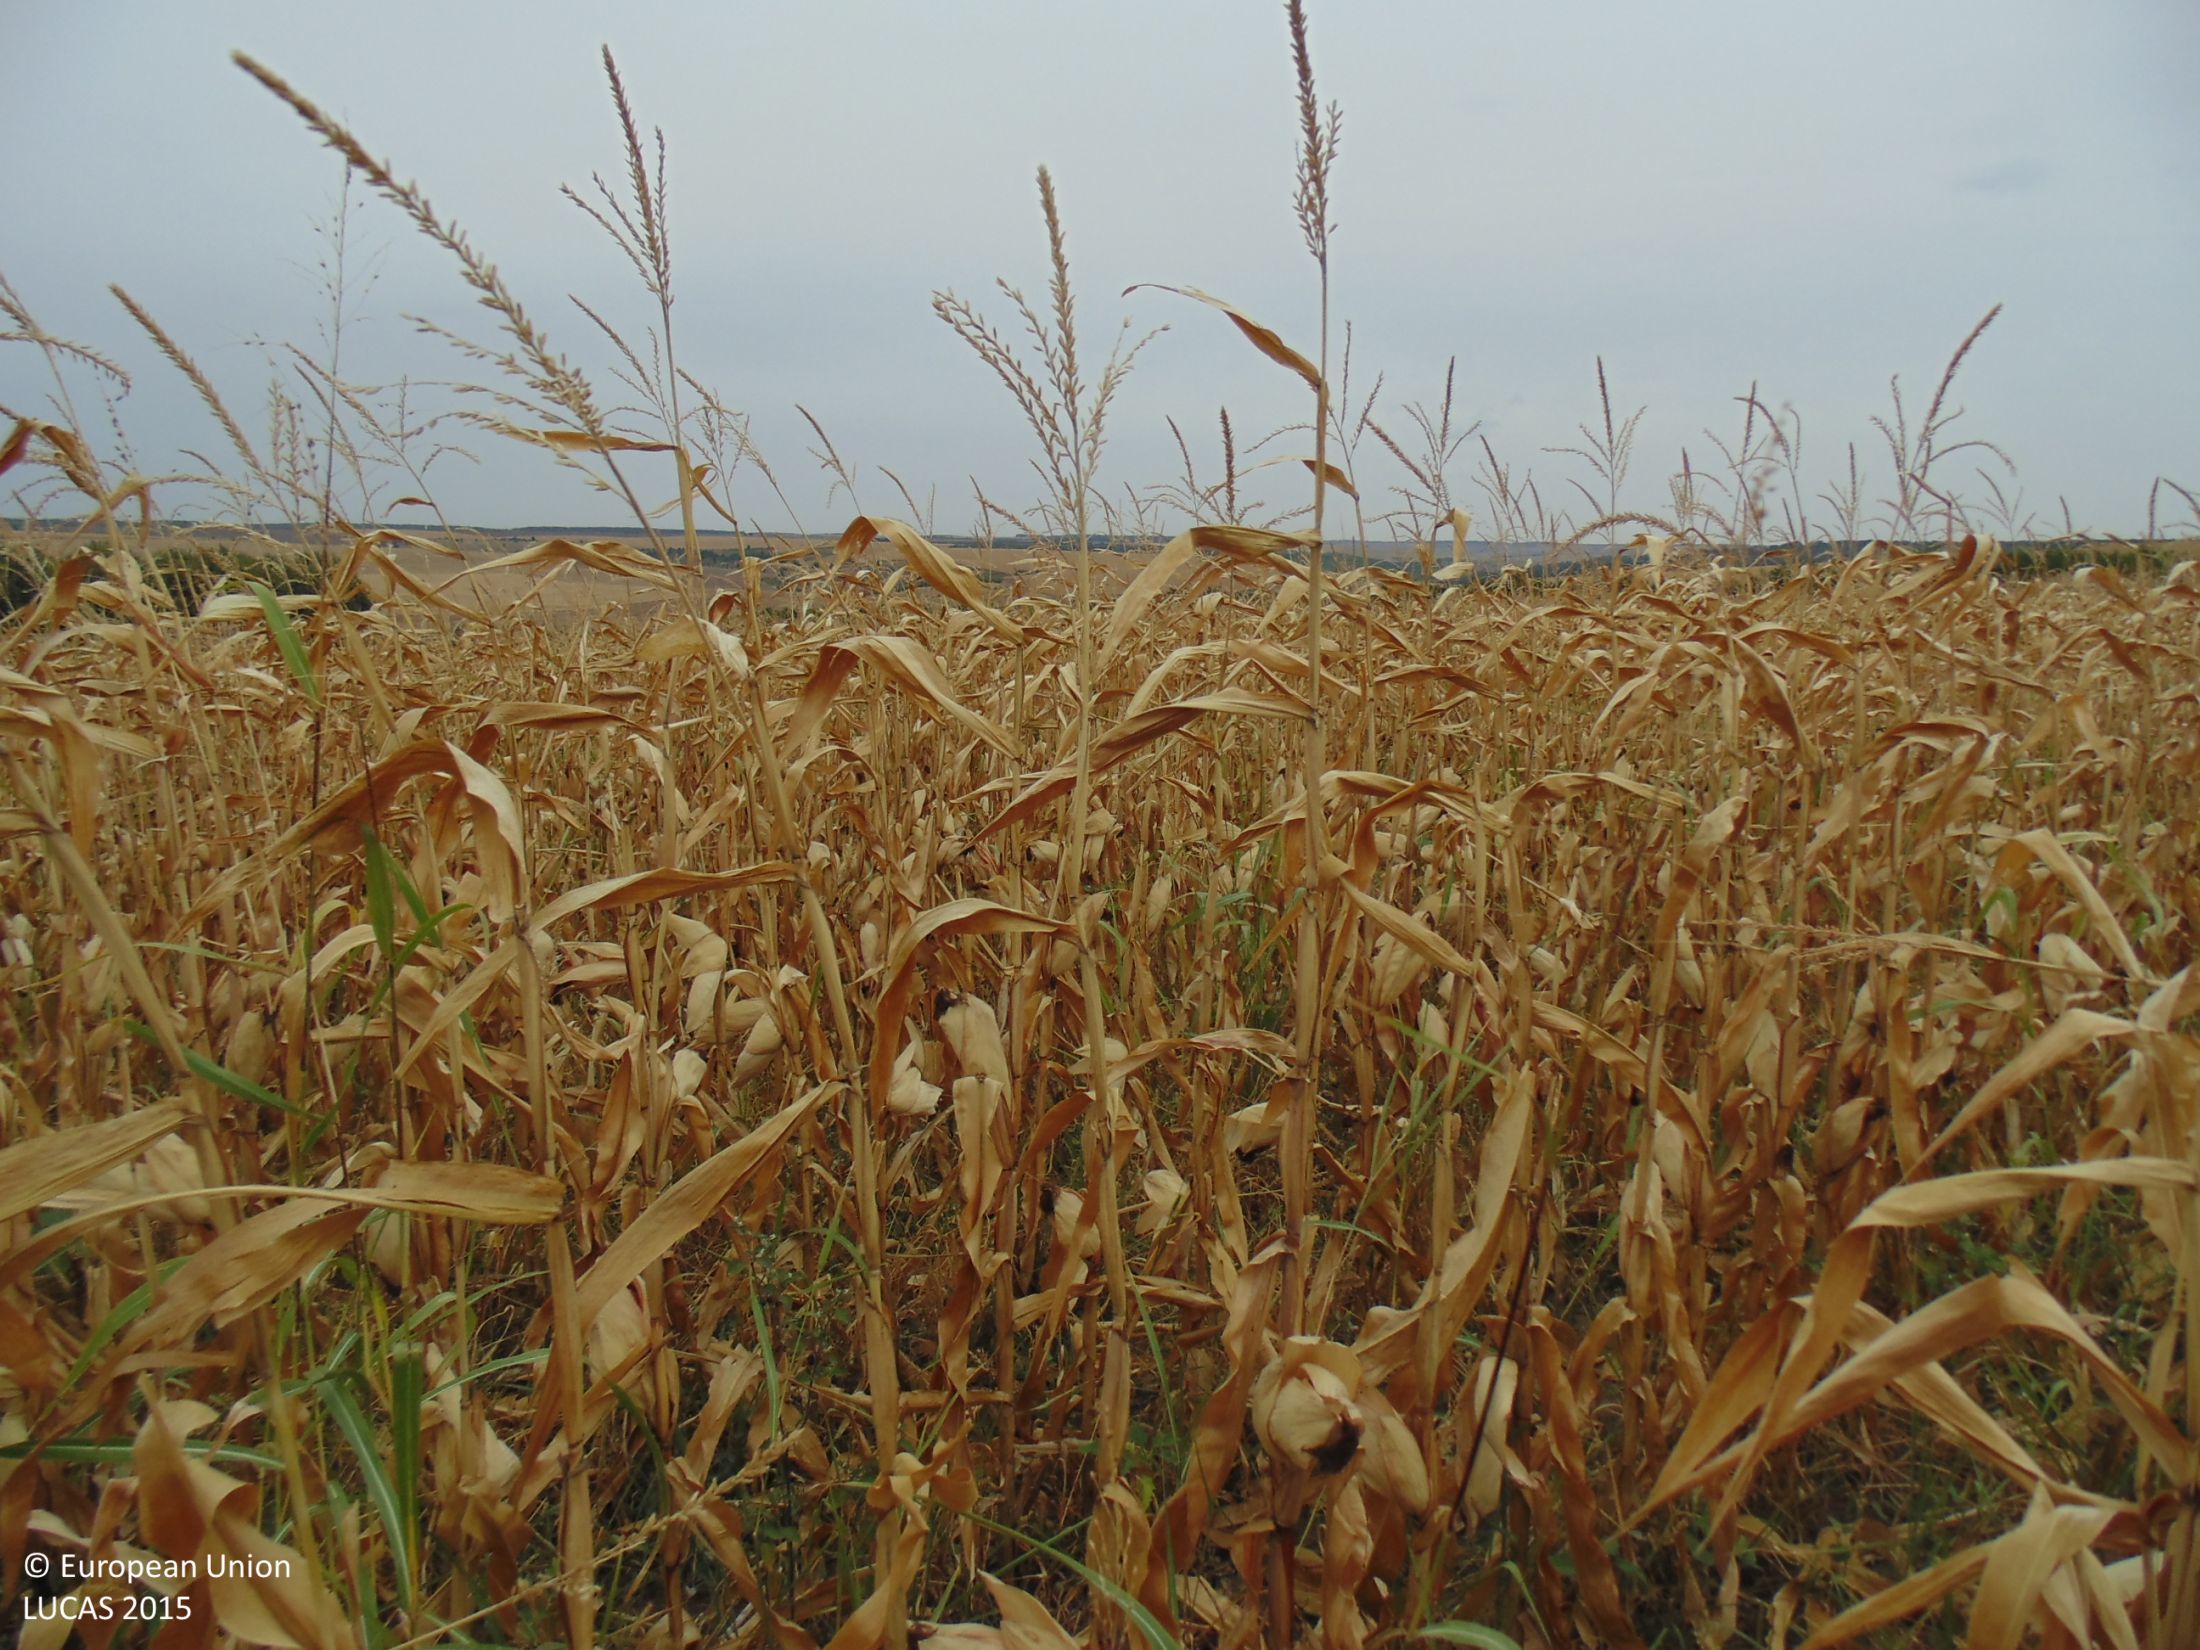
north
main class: Cropland
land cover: Maize
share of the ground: > 75 %
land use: Agriculture (excluding fallow land and kitchen gardens)
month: September
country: BG
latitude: 43.9557
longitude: 27.0597
